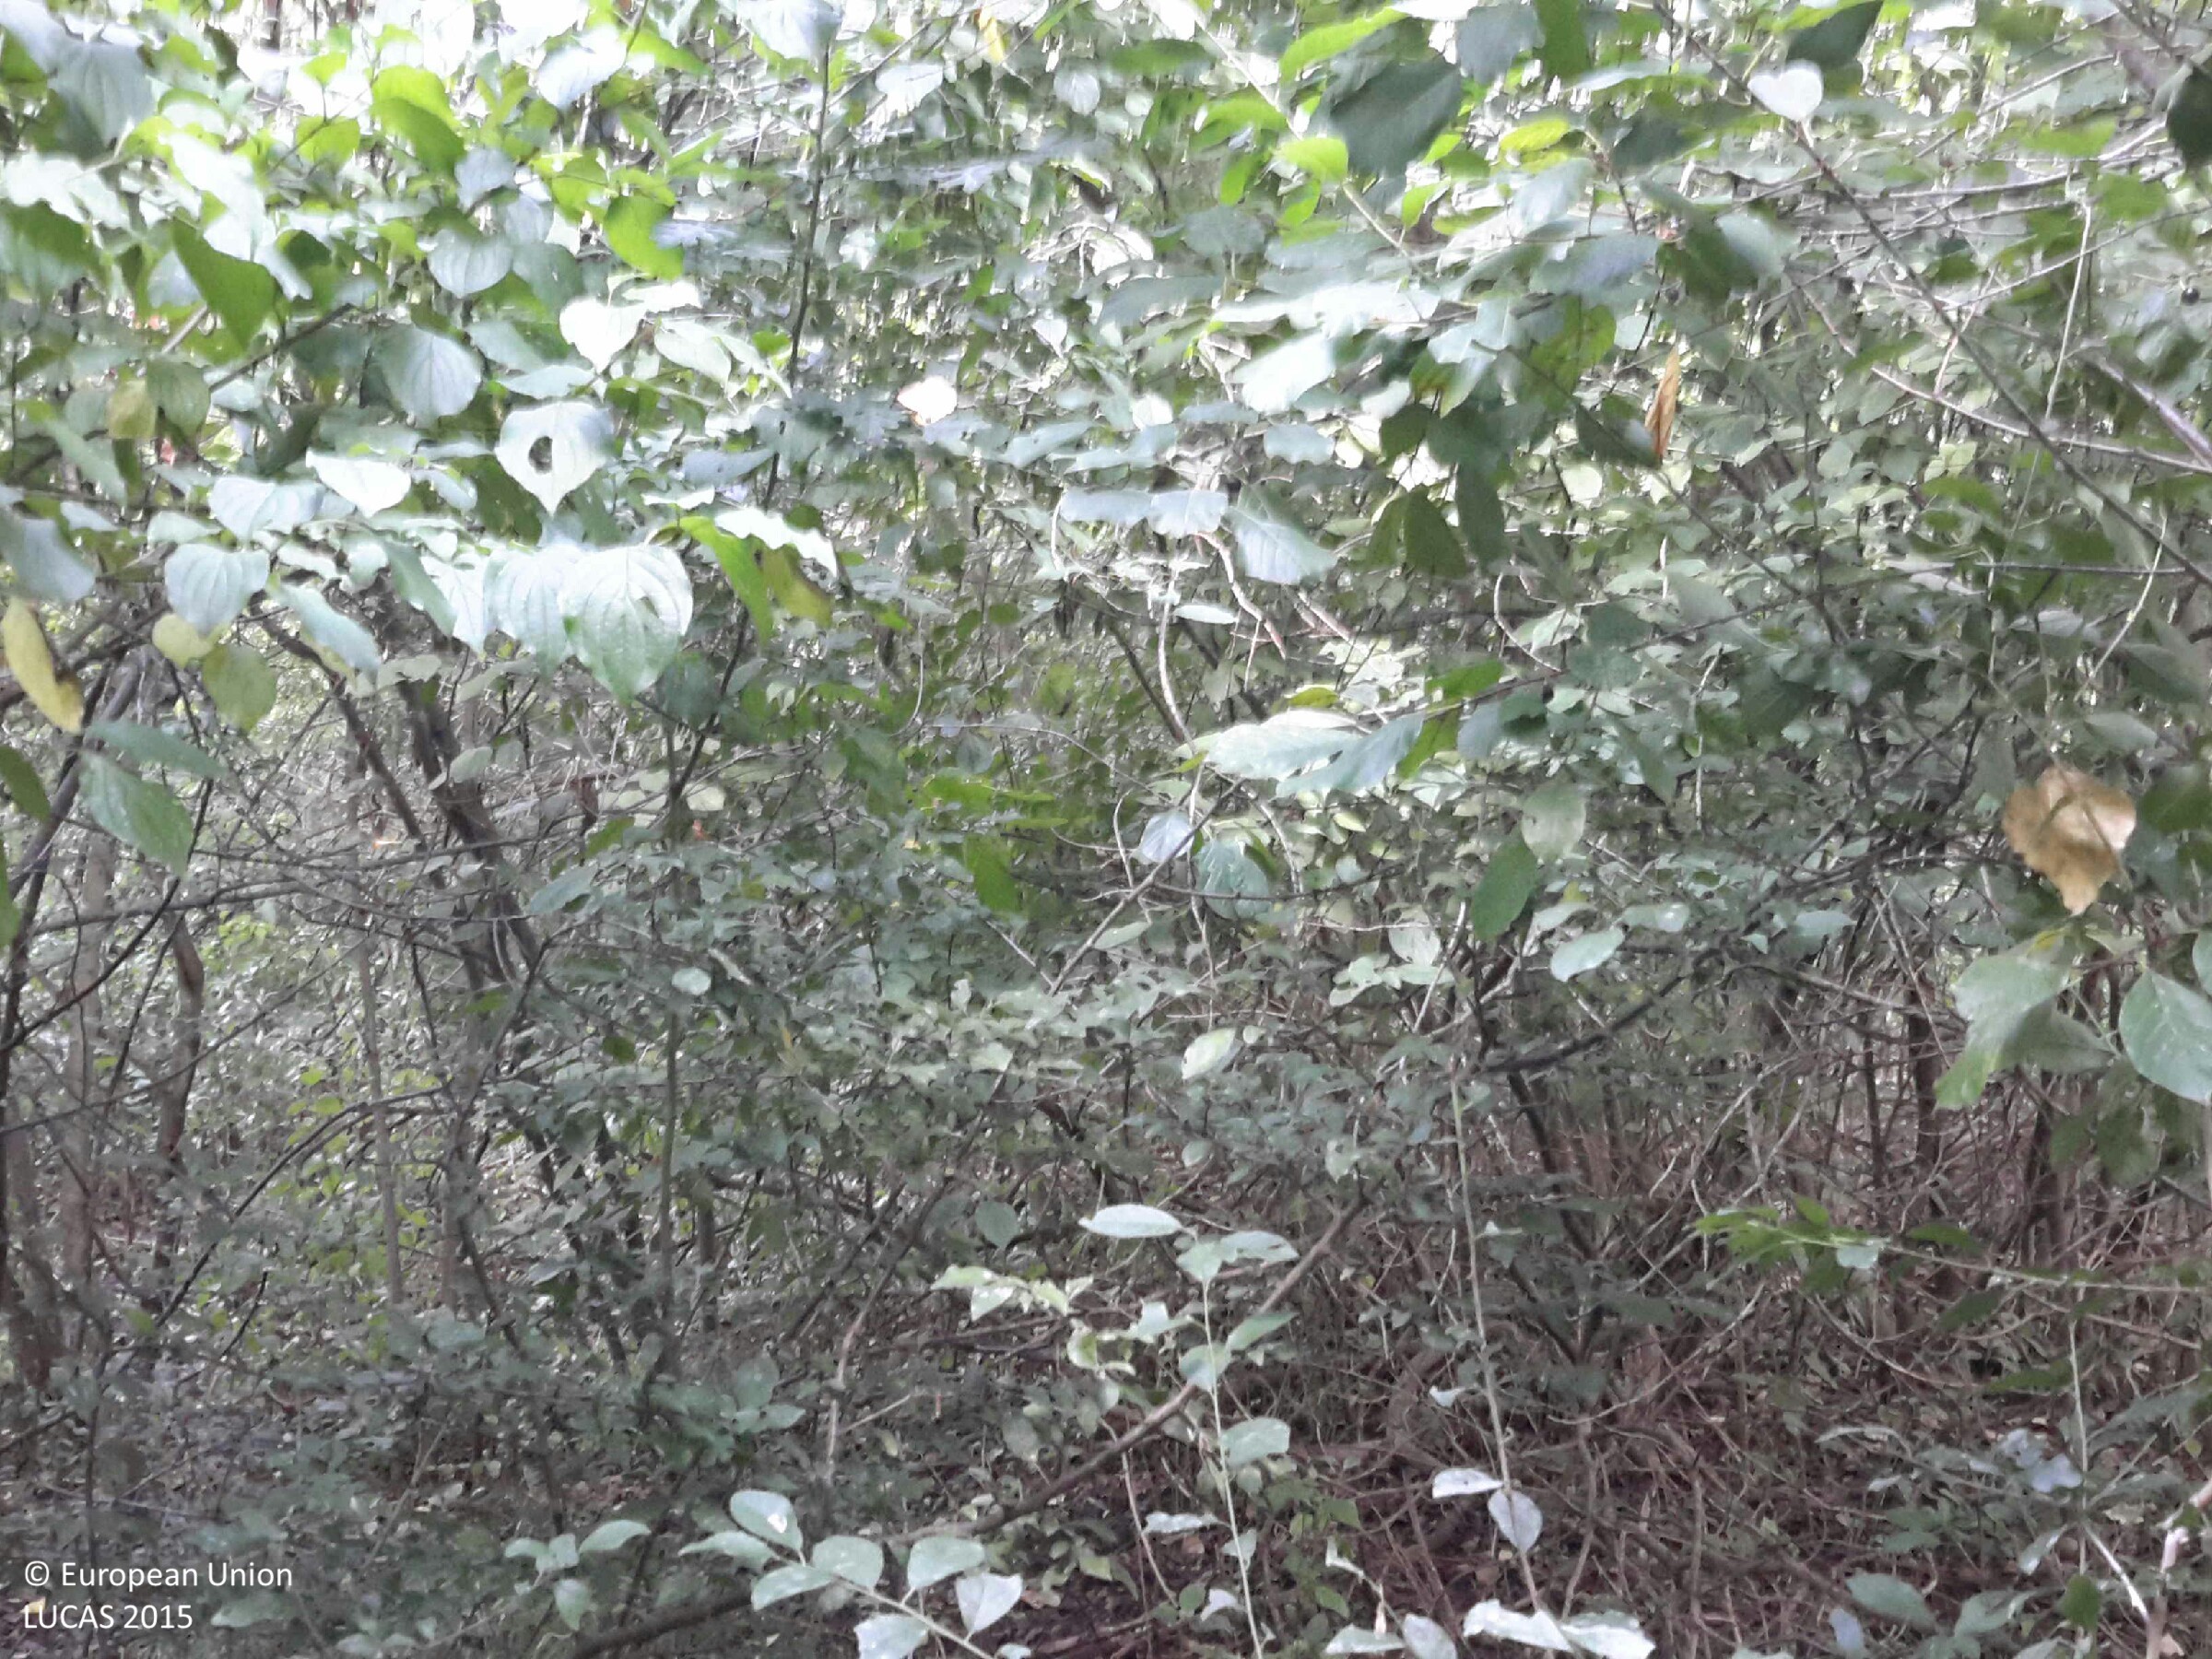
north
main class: Woodland
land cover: Broadleaved woodland
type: thermophilous deciduous forest
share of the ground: > 75 %
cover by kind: broadleaved forest trees 60 %, shrubs 30 %, herbaceous plants 10 %
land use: Forestry
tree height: > 5 m
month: August
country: HU
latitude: 47.2702
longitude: 17.3956
